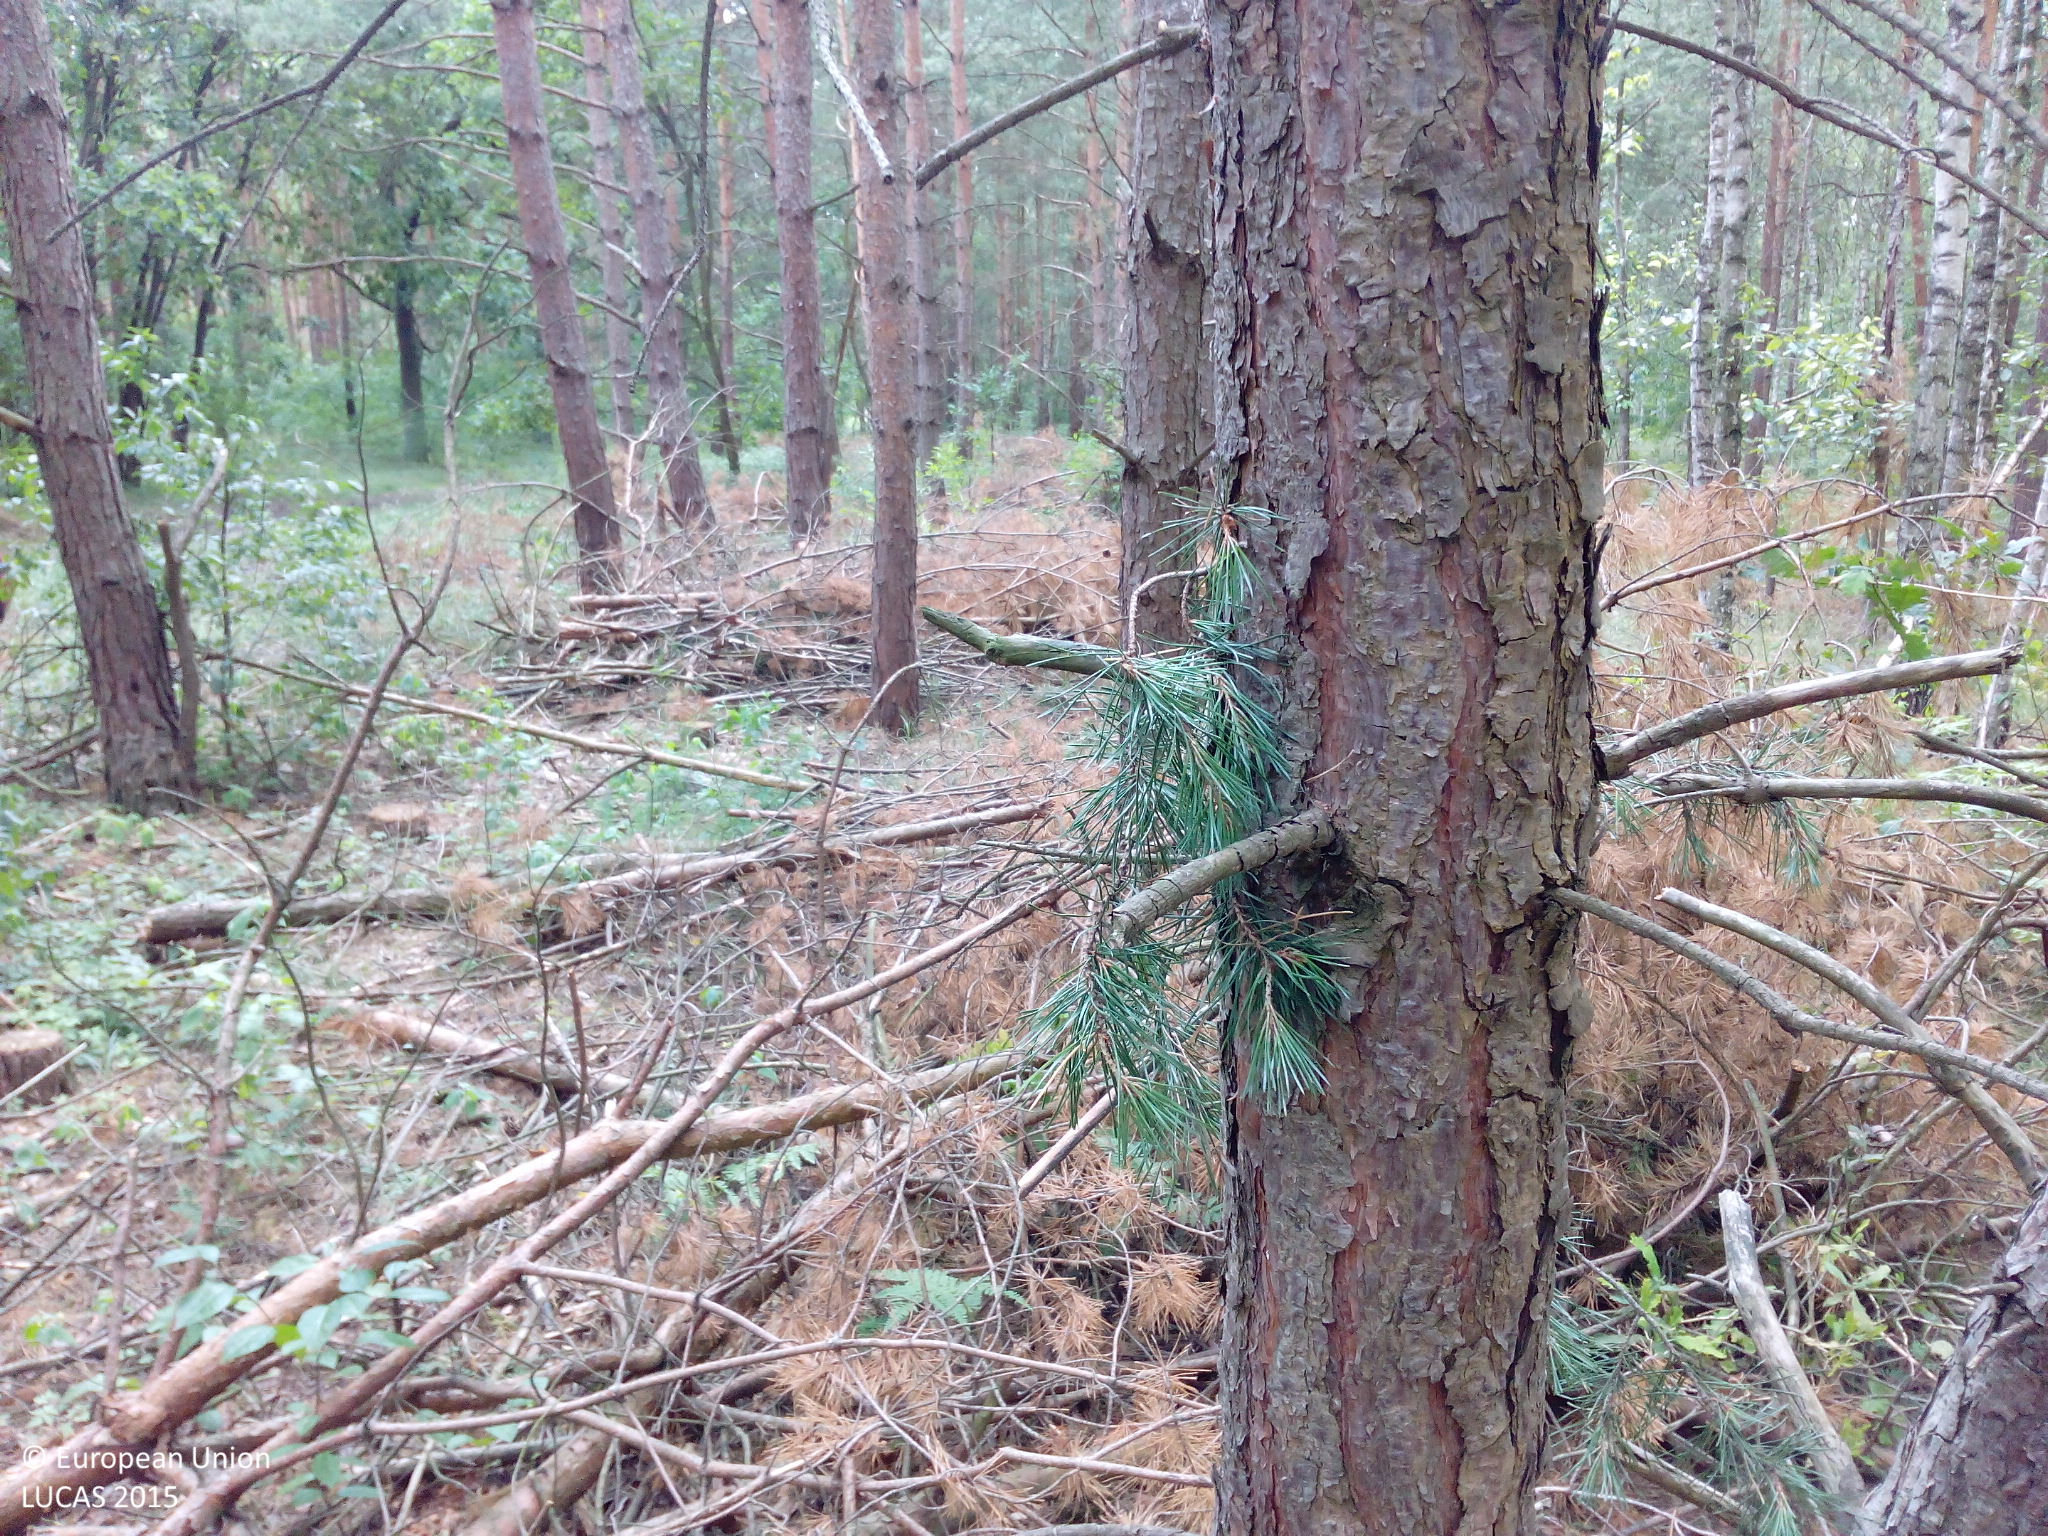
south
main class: Woodland
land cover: Pine dominated coniferous woodland
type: hemiboreal forest and nemoral coniferous forest and mixed broadleaved-coniferous forest
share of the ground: > 75 %
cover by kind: coniferous forest trees 80 %, herbaceous plants 15 %, broadleaved forest trees 5 %
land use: Forestry
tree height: > 5 m
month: July
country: DE
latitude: 52.4667
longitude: 13.6066
